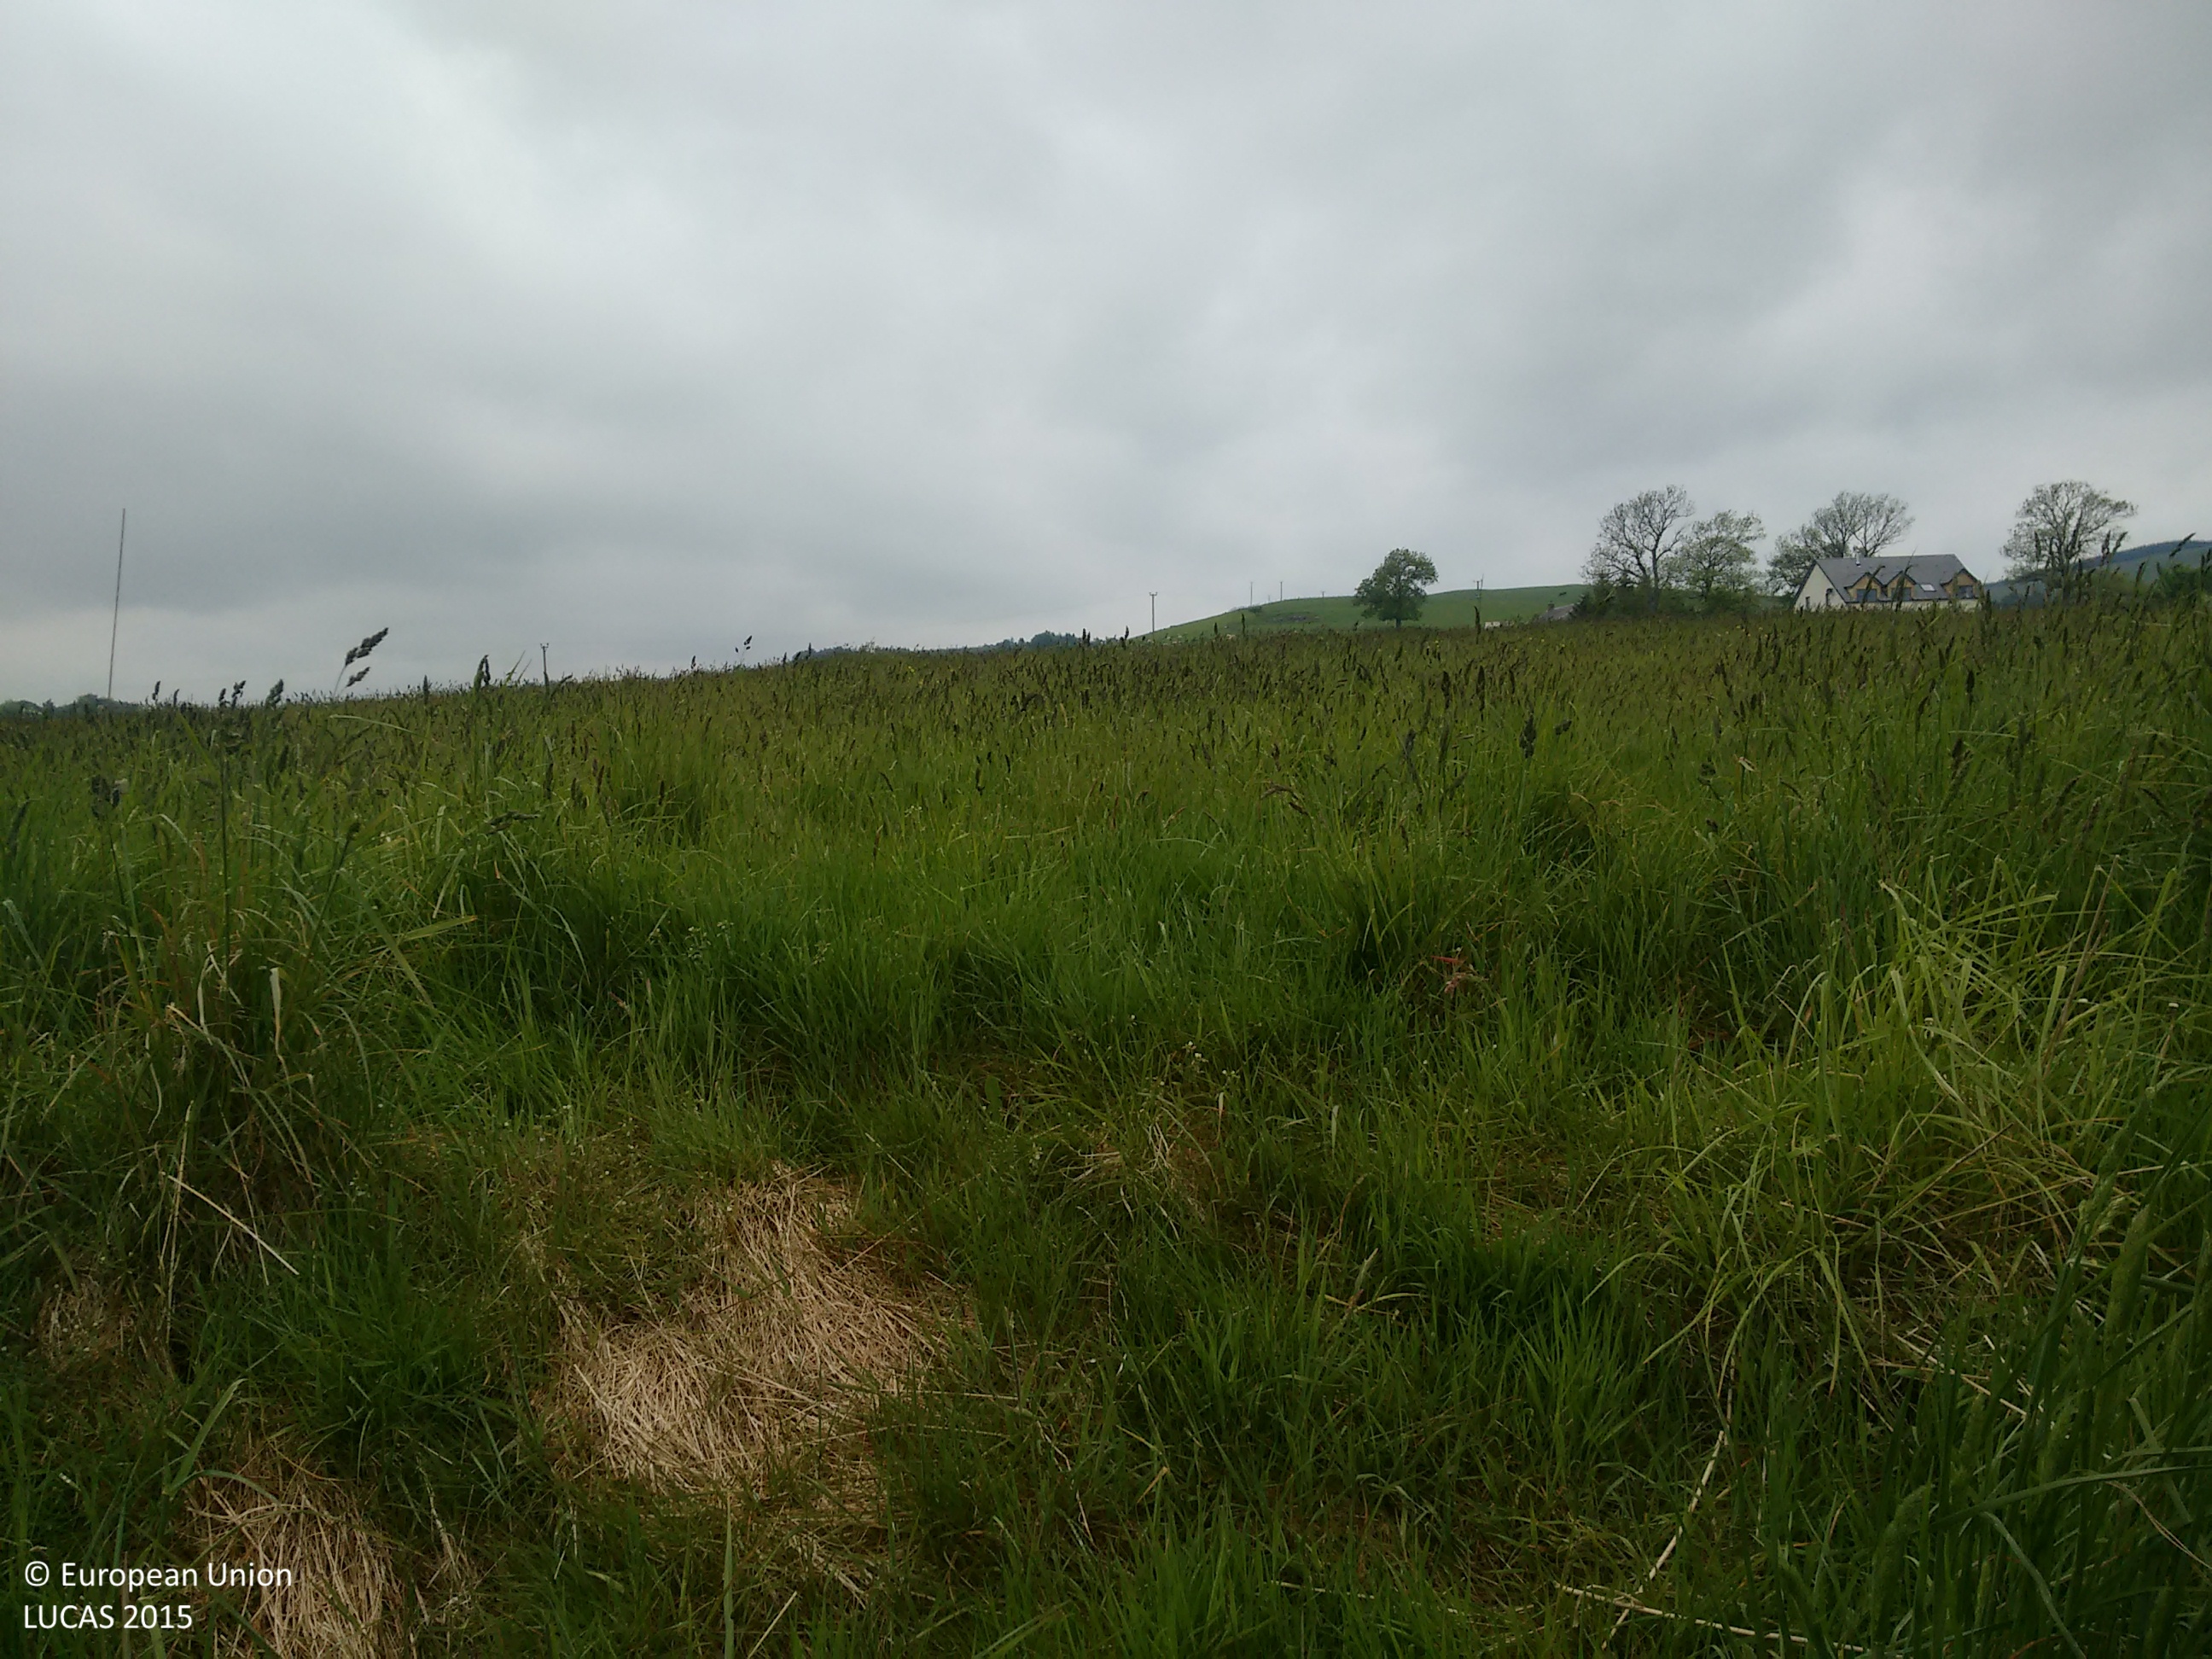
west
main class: Grassland
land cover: Grassland without tree/shrub cover
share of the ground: > 75 %
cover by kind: herbaceous plants 100 %
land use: Agriculture (excluding fallow land and kitchen gardens)
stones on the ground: < 10 %
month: June
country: GB
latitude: 55.6308
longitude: -3.5325
